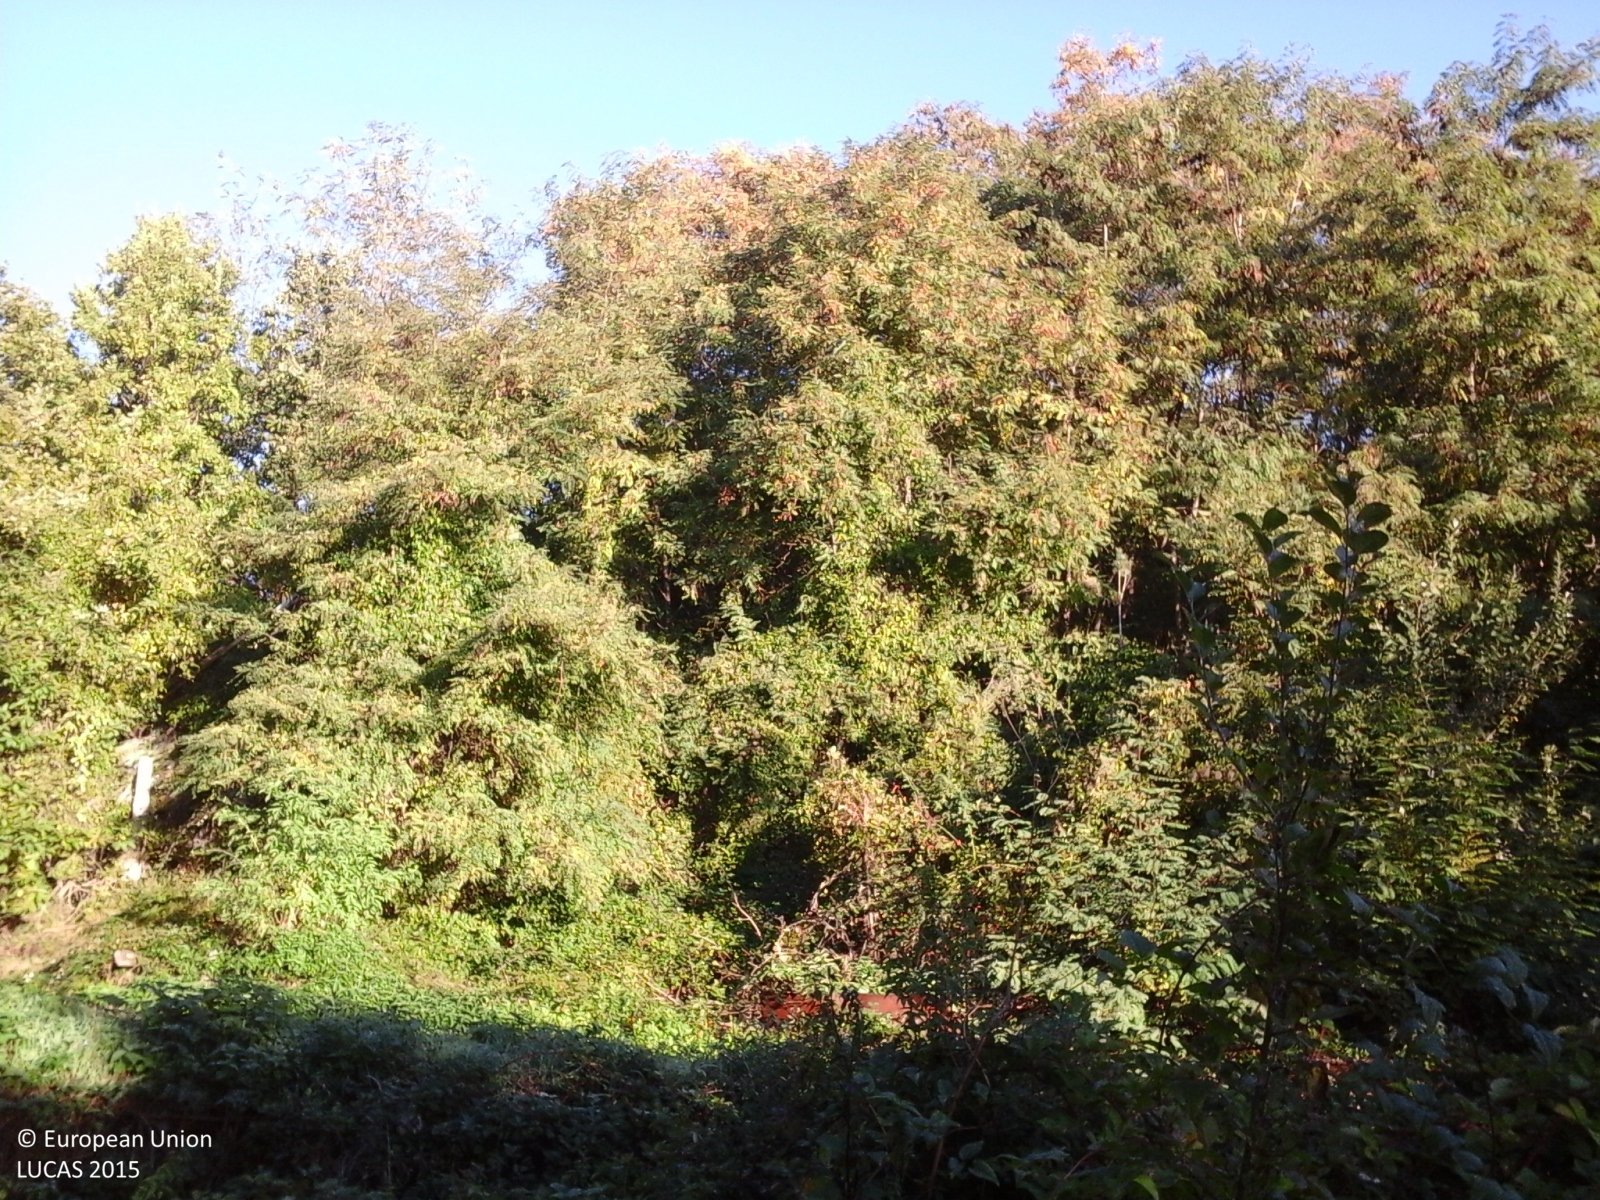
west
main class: Woodland
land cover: Broadleaved woodland
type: thermophilous deciduous forest
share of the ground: > 75 %
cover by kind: broadleaved forest trees 70 %, shrubs 15 %, herbaceous plants 10 %, coniferous forest trees 5 %
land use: Forestry
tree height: > 5 m
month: October
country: IT
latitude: 44.0756
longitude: 7.8448
